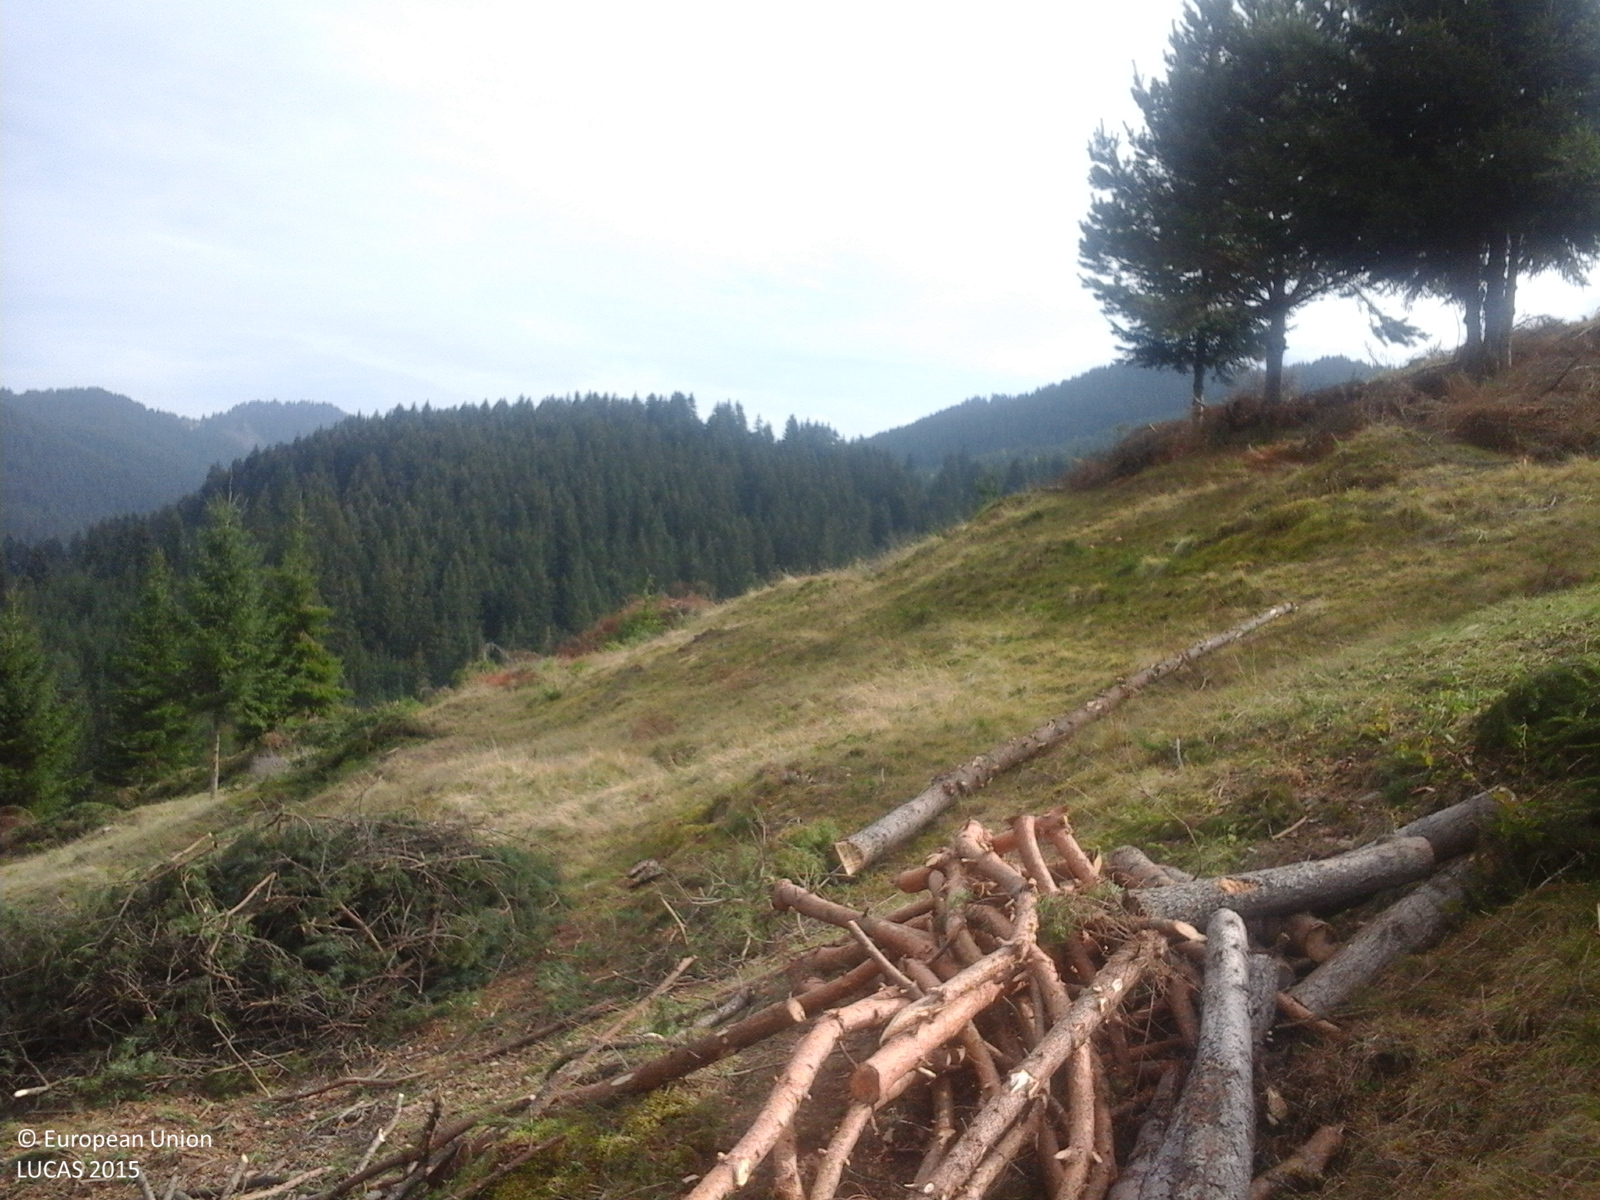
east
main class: Grassland
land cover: Grassland with sparse tree/shrub cover
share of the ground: > 75 %
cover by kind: herbaceous plants 85 %, shrubs 10 %, broadleaved forest trees 5 %
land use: Fallow land
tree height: > 5 m
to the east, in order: Grassland with sparse tree/shrub cover; Spruce dominated coniferous woodland
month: October
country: RO
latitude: 46.4957
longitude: 25.8701
